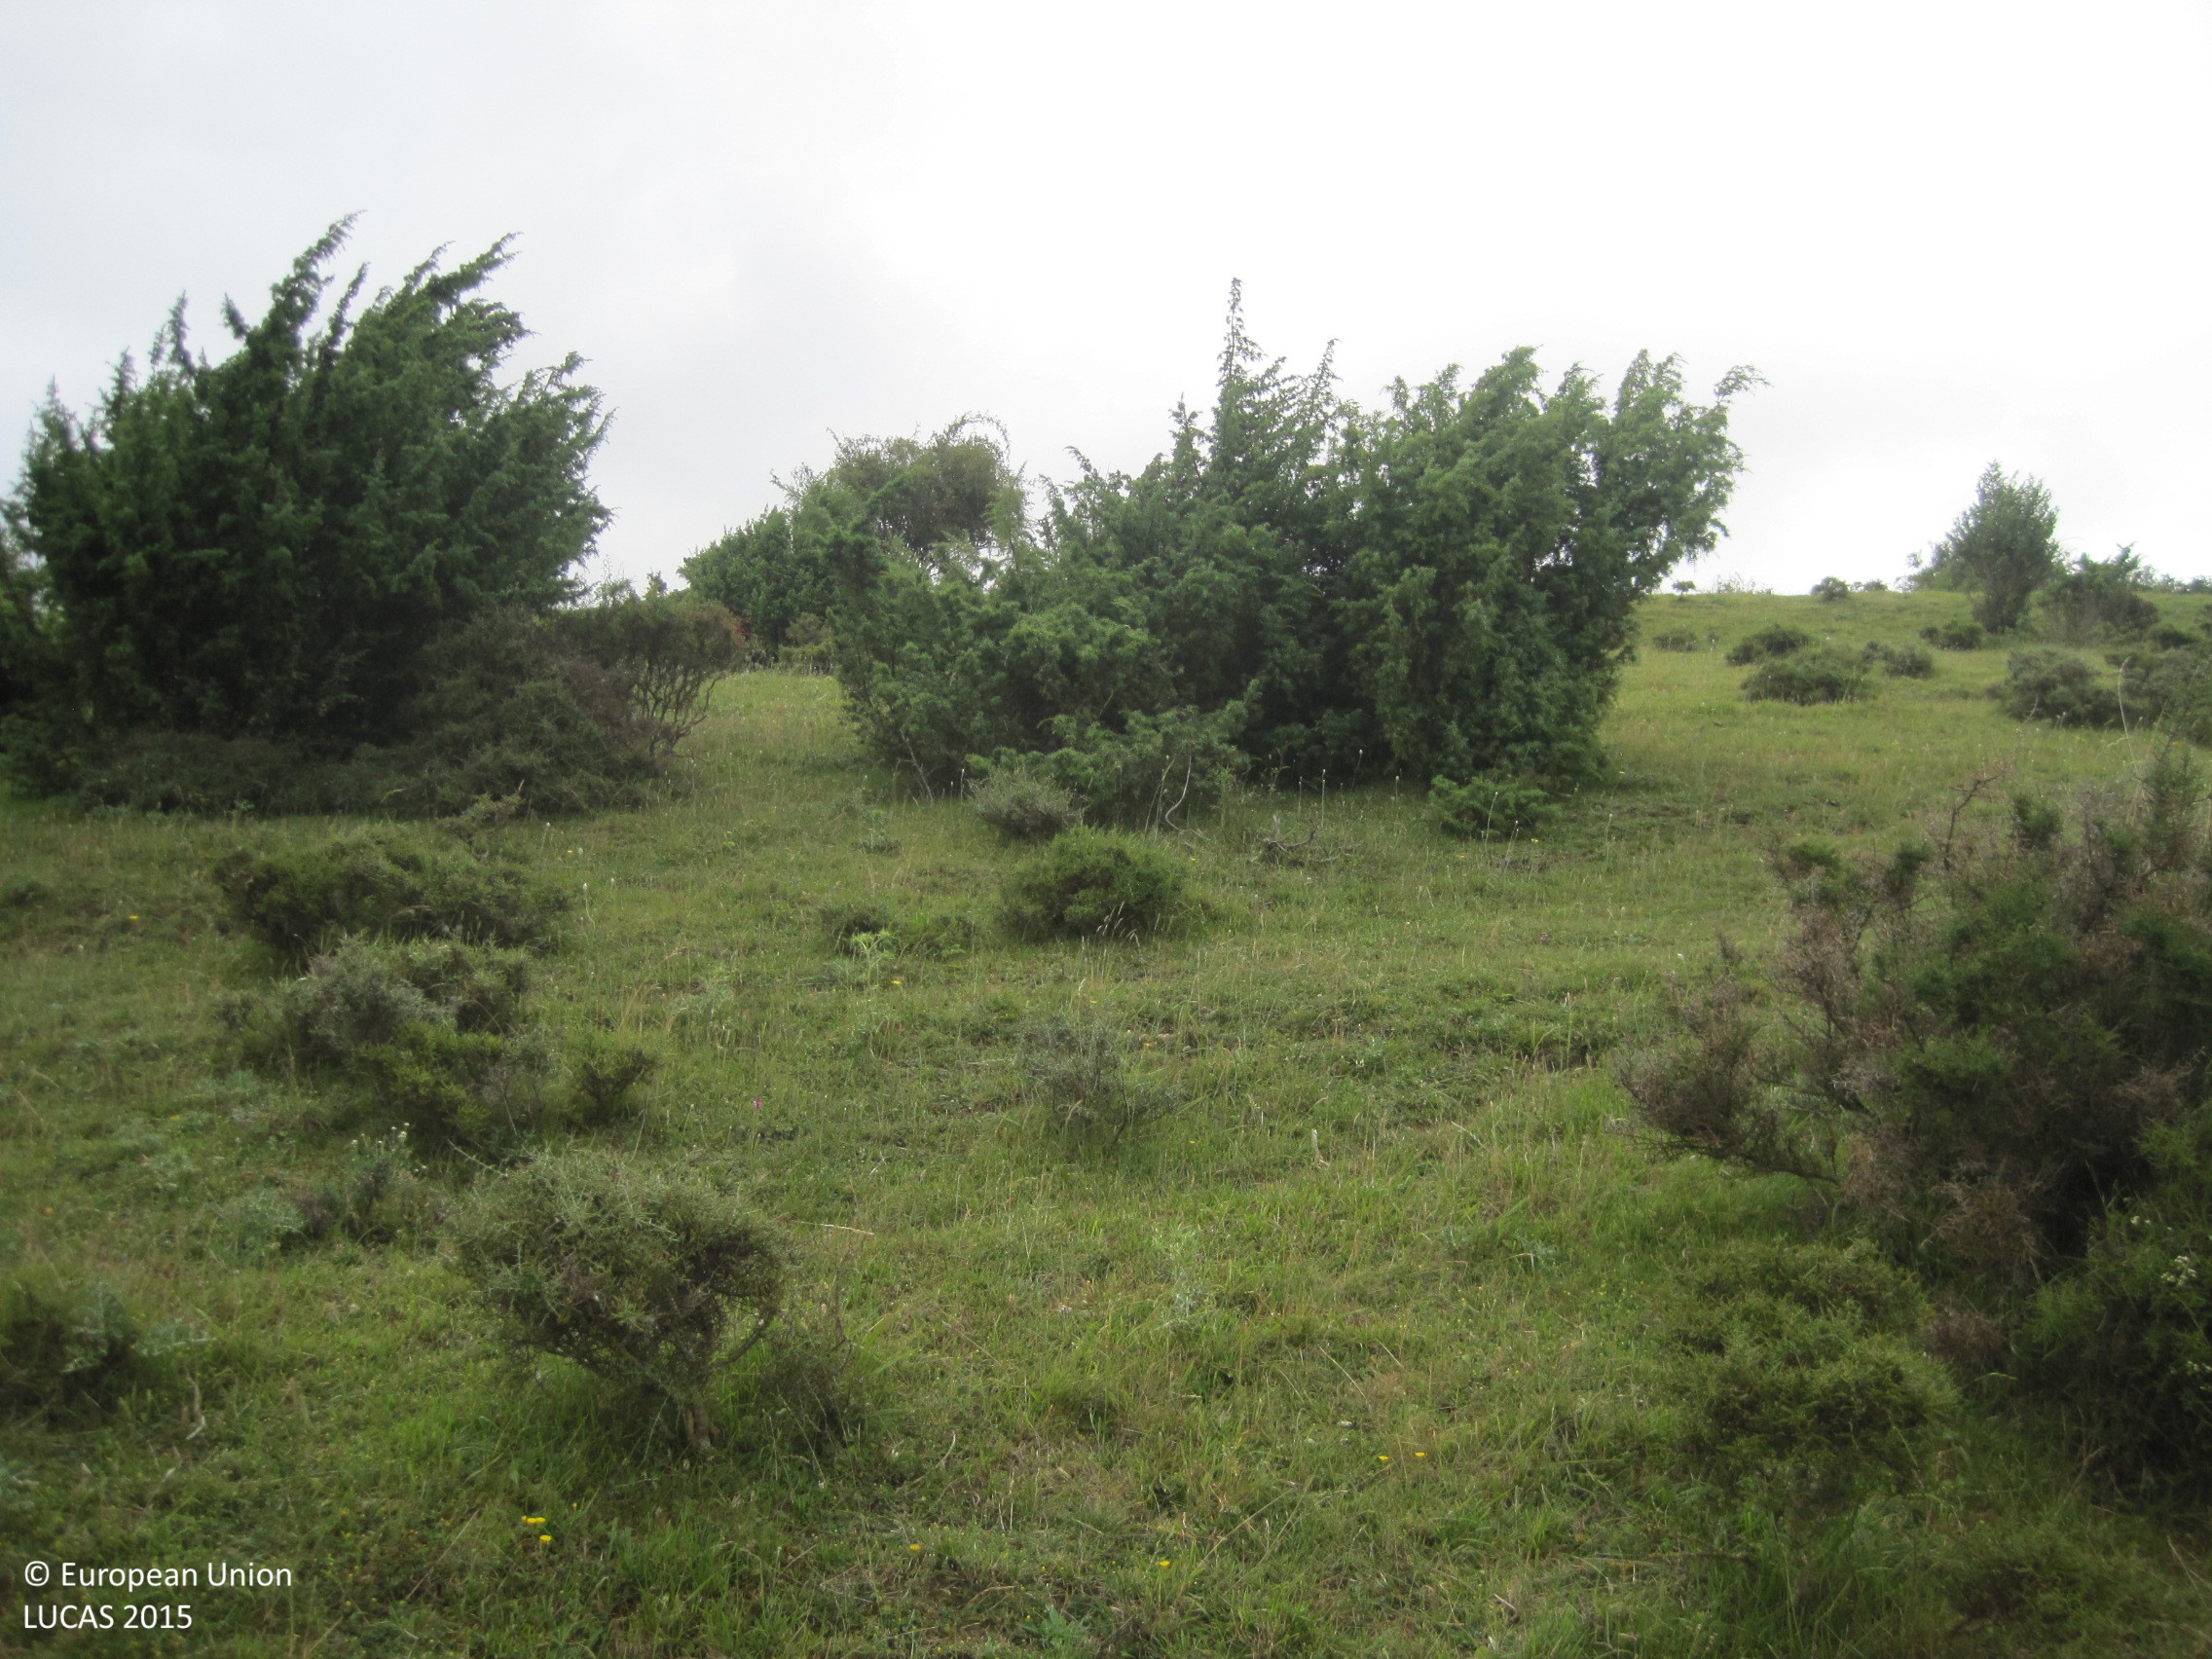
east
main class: Shrubland
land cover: Shrubland without tree cover
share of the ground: > 75 %
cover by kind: herbaceous plants 80 %, shrubs 20 %
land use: Agriculture (excluding fallow land and kitchen gardens)
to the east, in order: Shrubland without tree cover; Fences; Dry pulses; Tracks; Oats; Electric lines; Oats
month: June
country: ES
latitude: 42.8604
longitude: -1.7534
